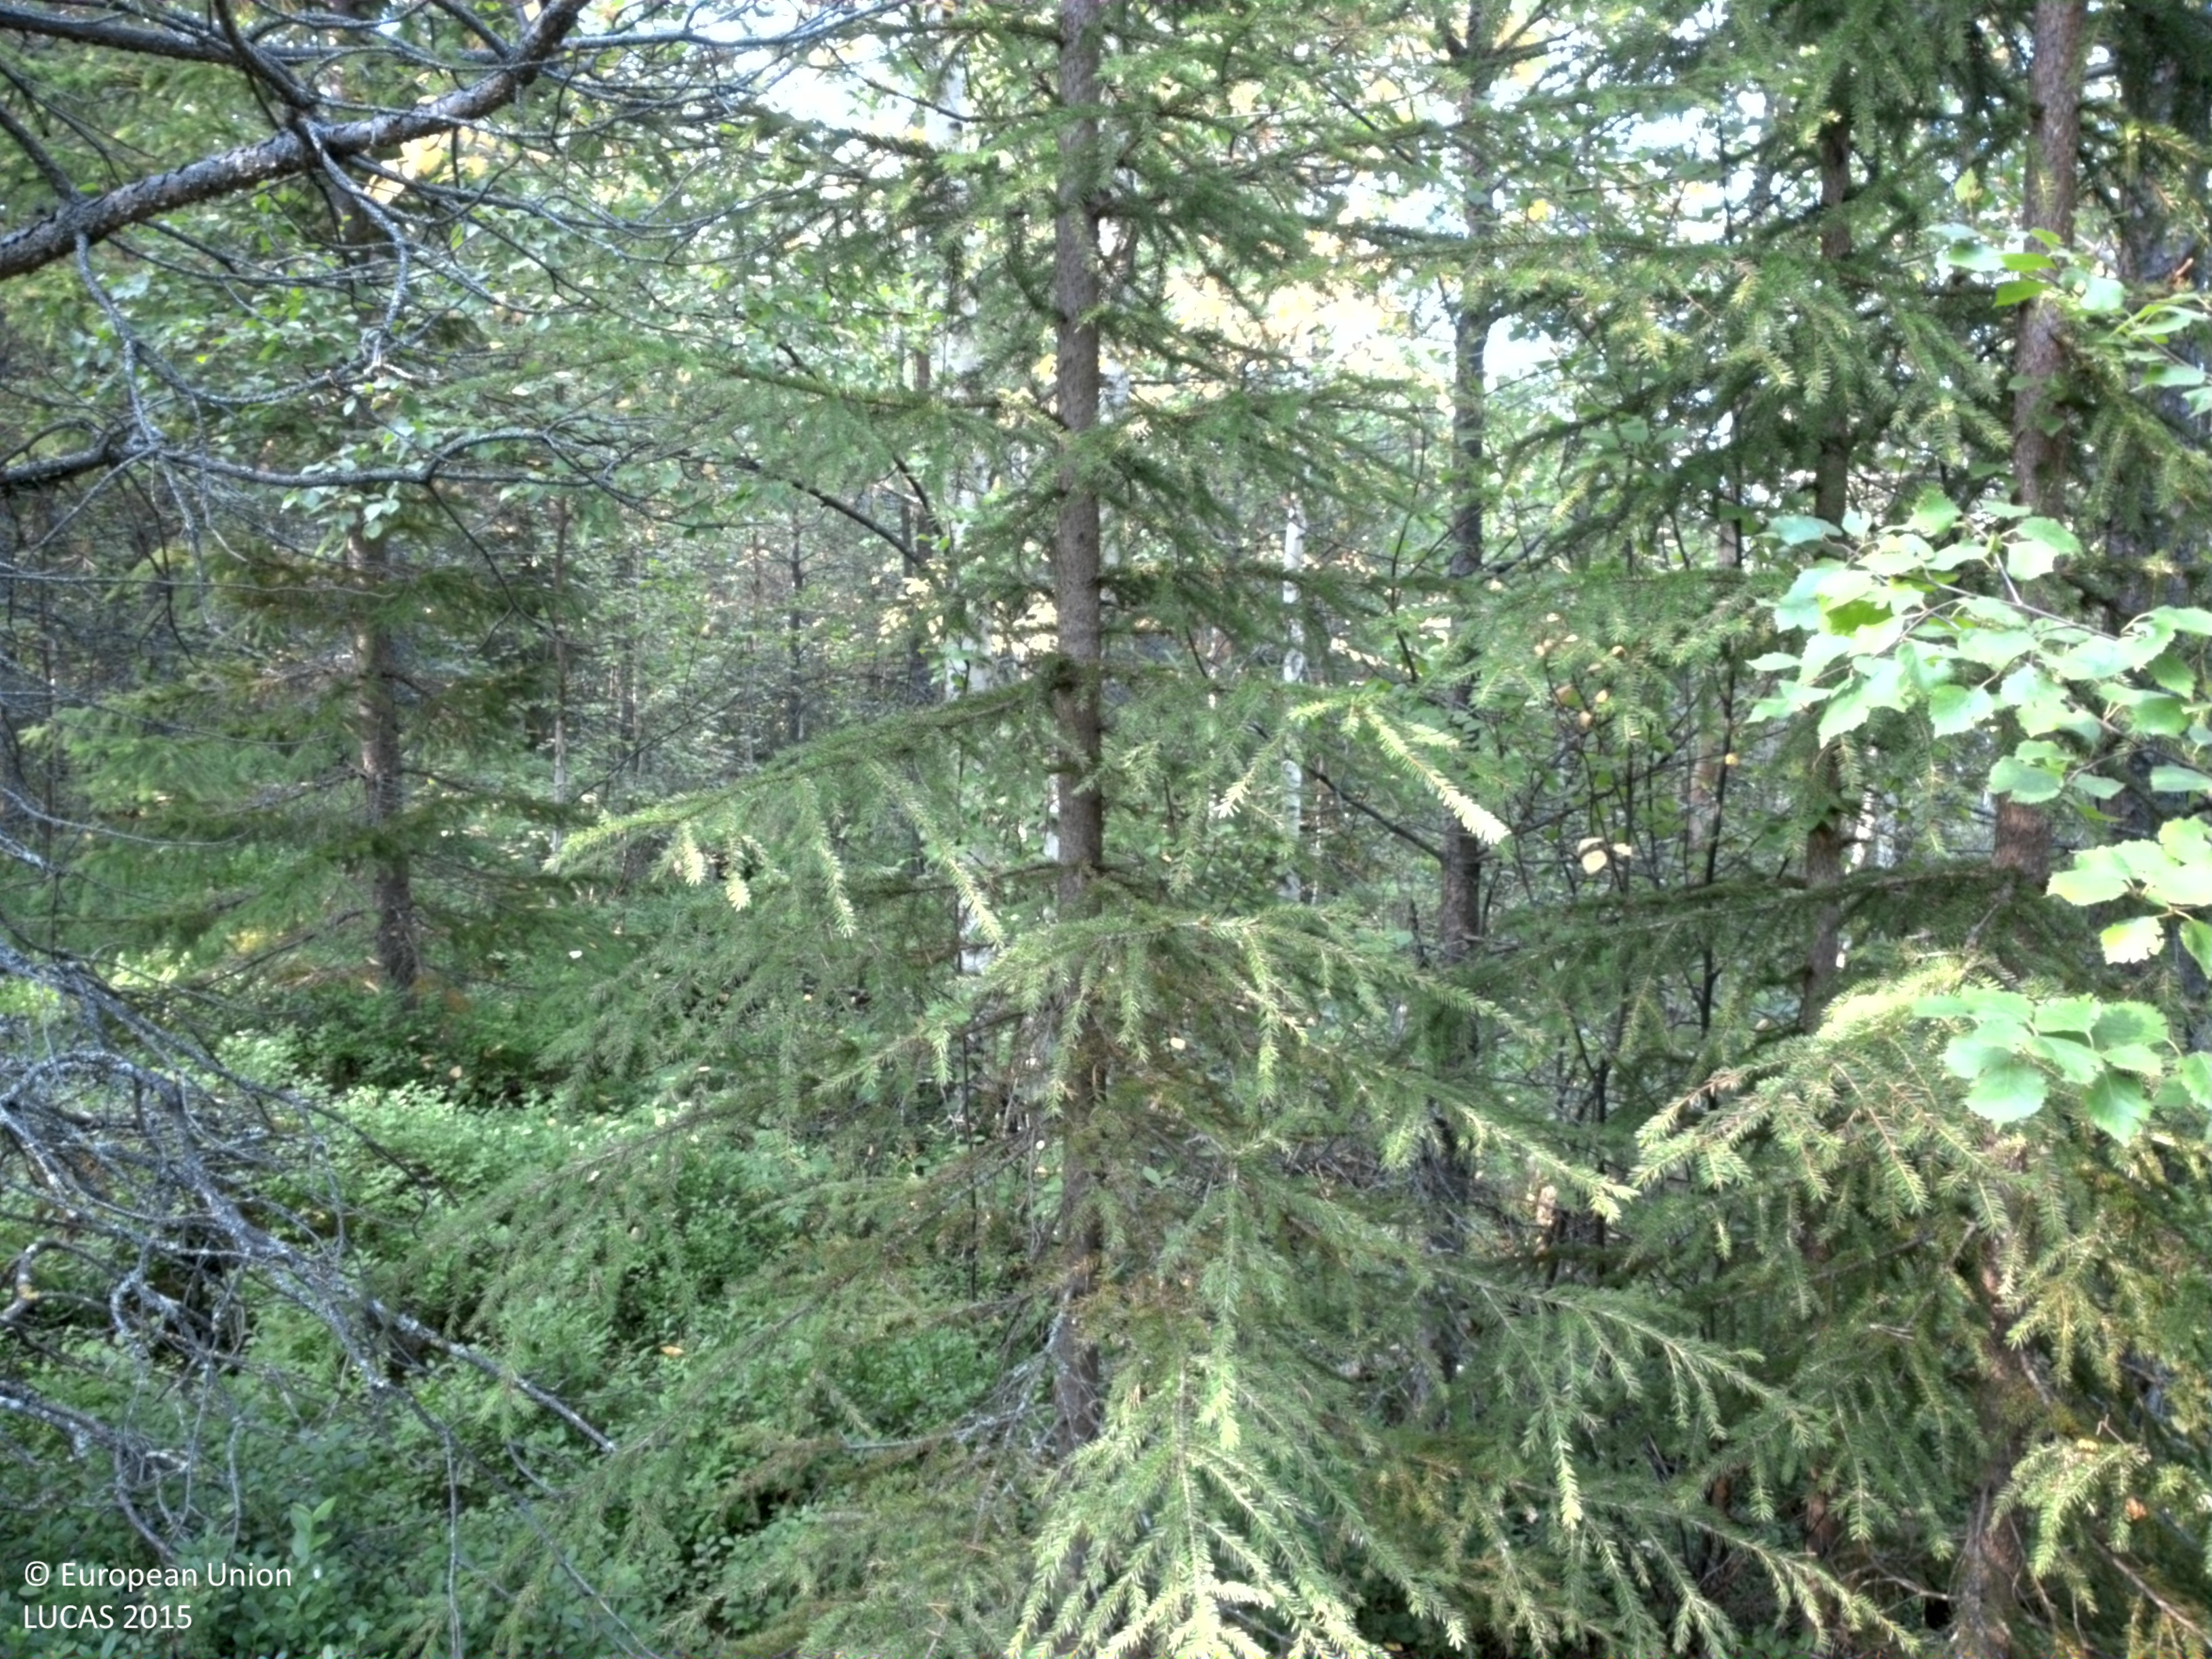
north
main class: Woodland
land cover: Pine dominated mixed woodland
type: boreal forest
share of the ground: 50 - 75 %
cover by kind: coniferous forest trees 45 %, shrubs 40 %, broadleaved forest trees 15 %
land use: Forestry
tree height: > 5 m
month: August
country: SE
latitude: 64.4401
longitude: 18.8815
